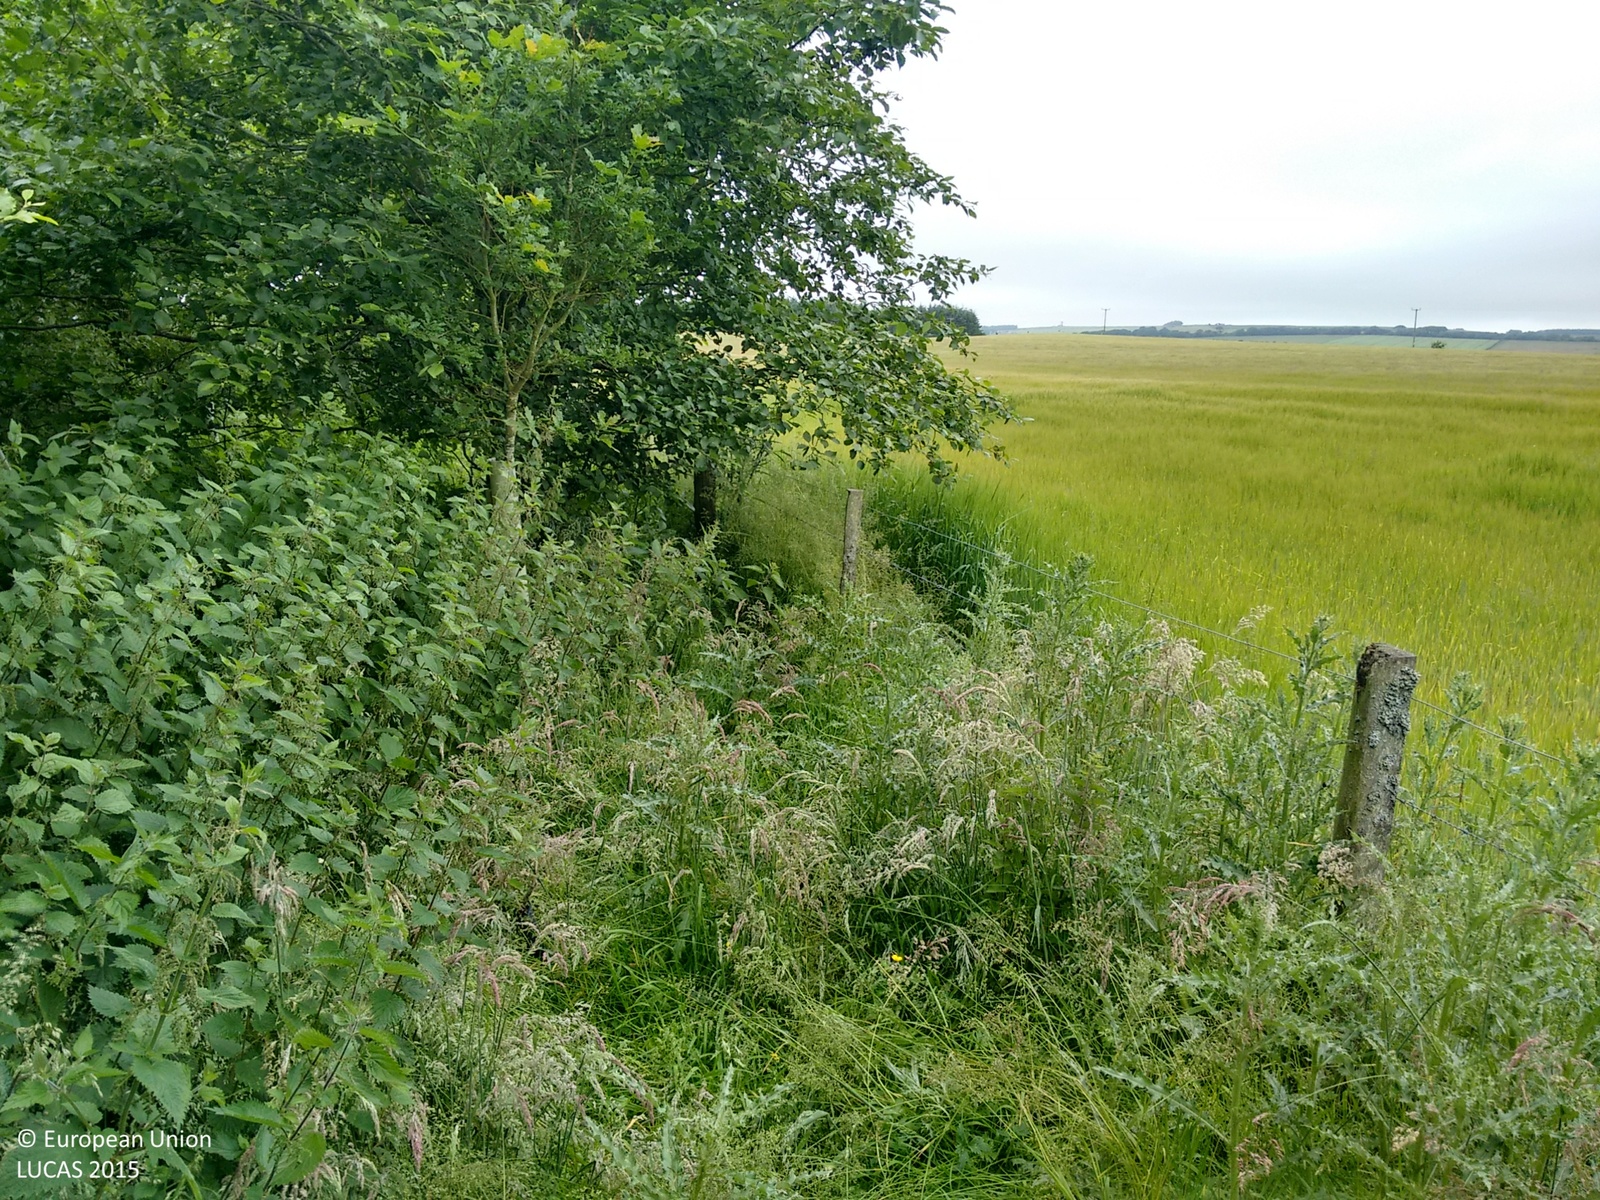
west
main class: Woodland
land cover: Broadleaved woodland
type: mesophytic deciduous forest
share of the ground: > 75 %
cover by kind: broadleaved forest trees 90 %, herbaceous plants 10 %
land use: Forestry
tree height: > 5 m
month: July
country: GB
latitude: 57.4258
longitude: -1.9857
